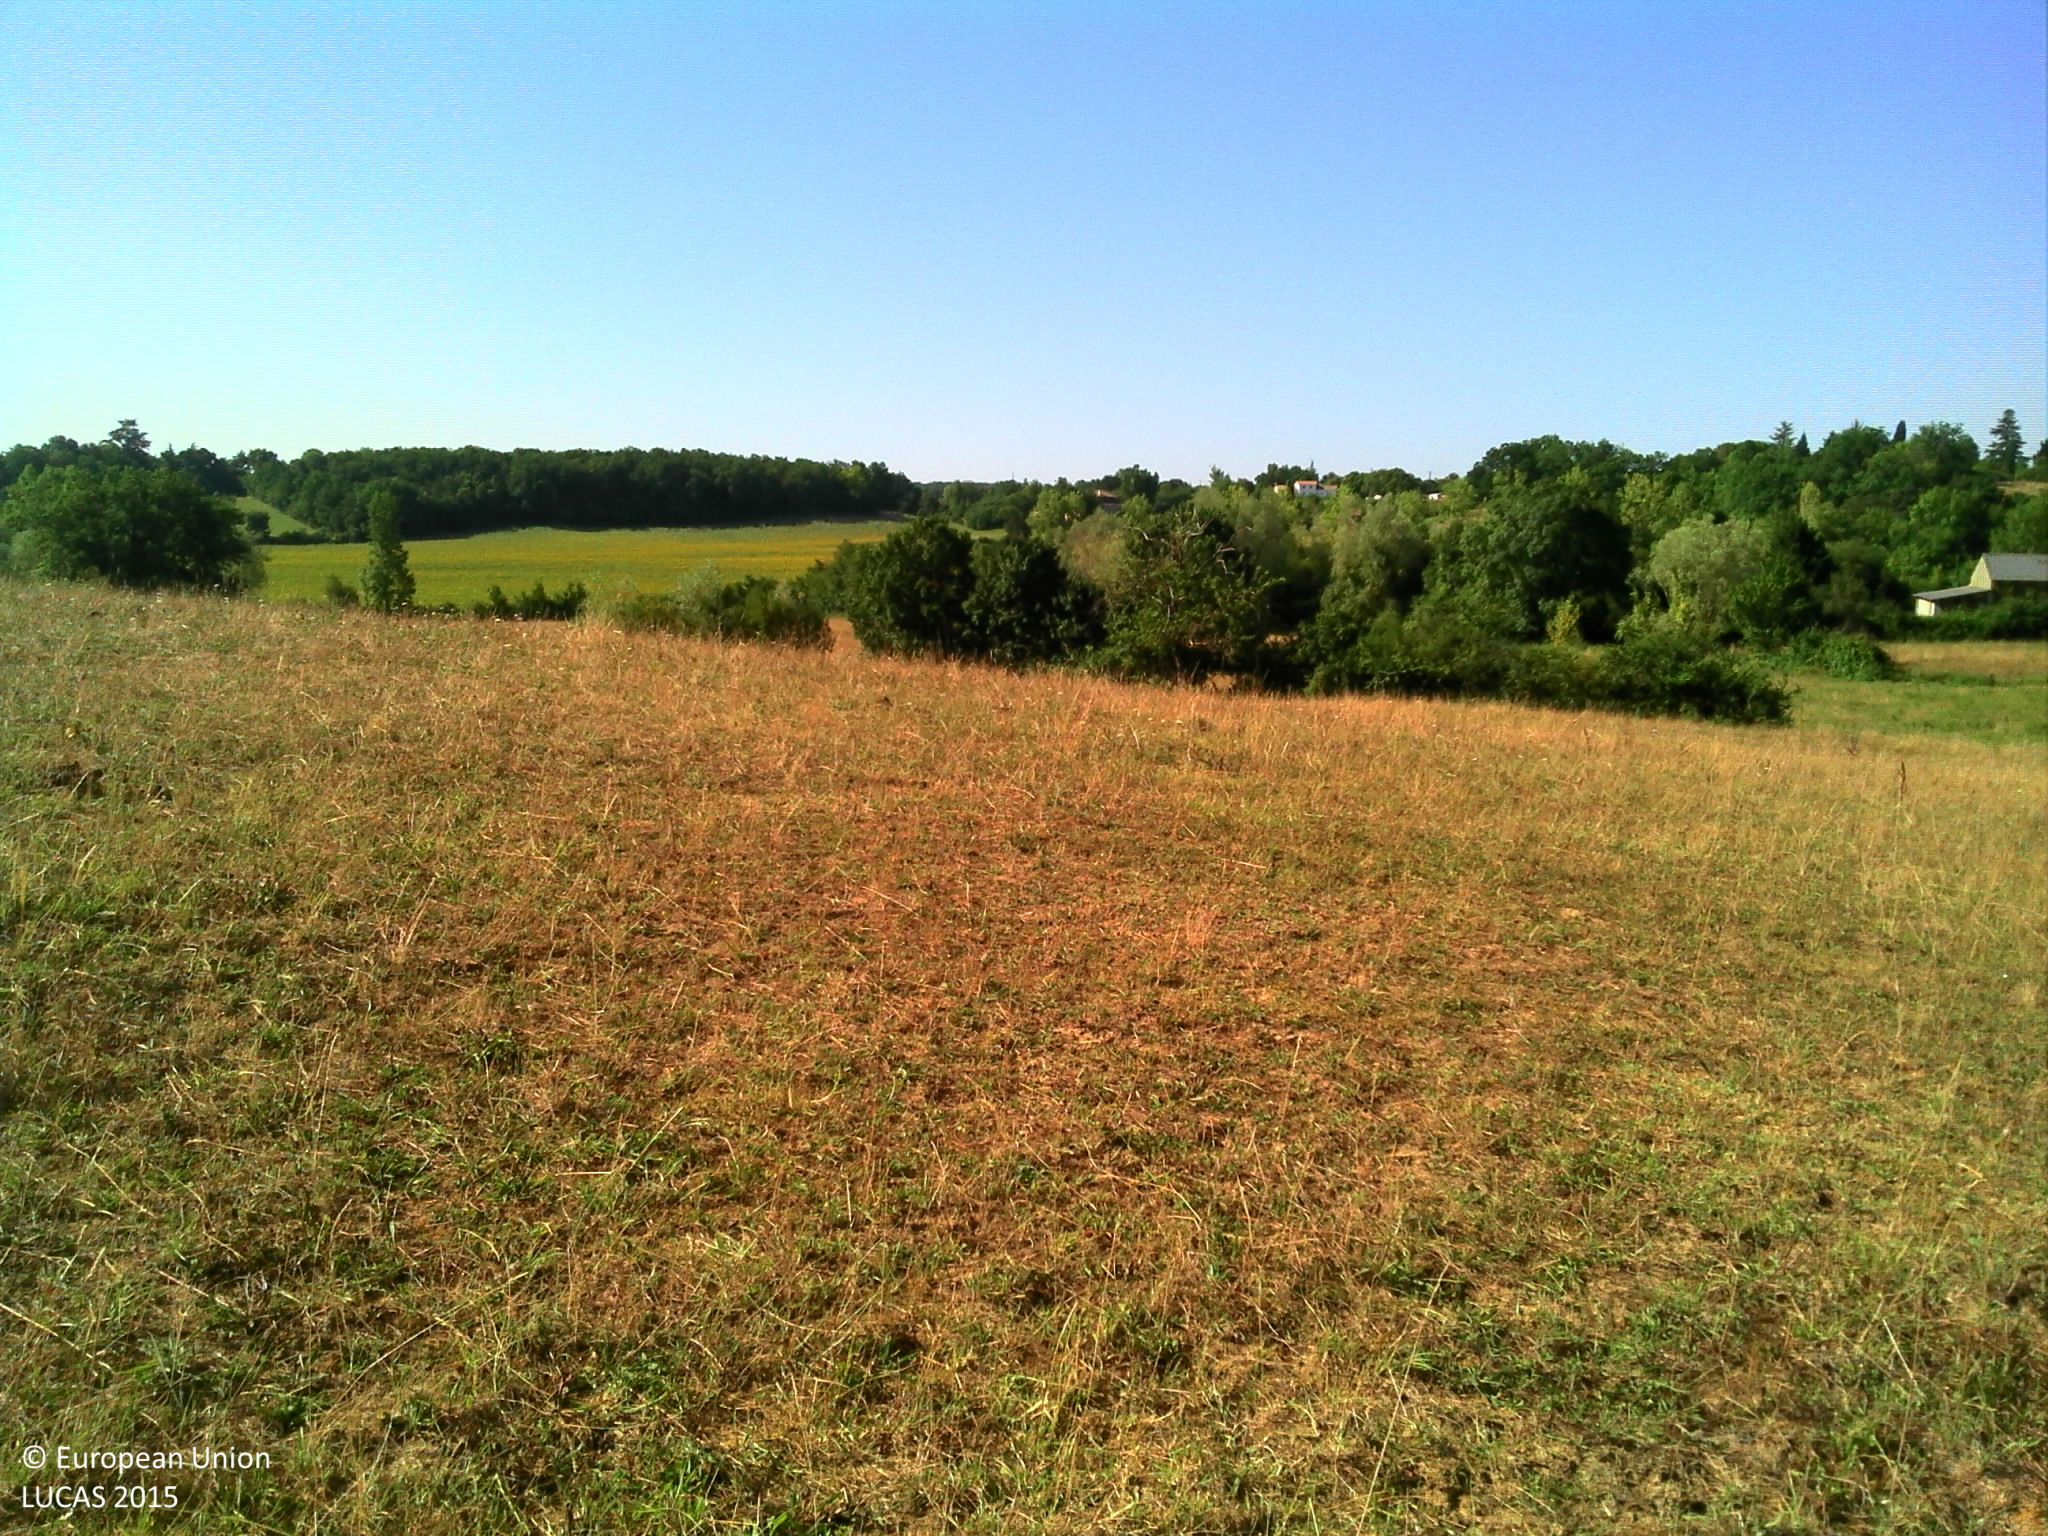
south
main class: Grassland
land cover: Grassland without tree/shrub cover
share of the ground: > 75 %
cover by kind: herbaceous plants 100 %
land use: Agriculture (excluding fallow land and kitchen gardens)
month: July
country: FR
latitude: 44.6487
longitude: 0.5983
